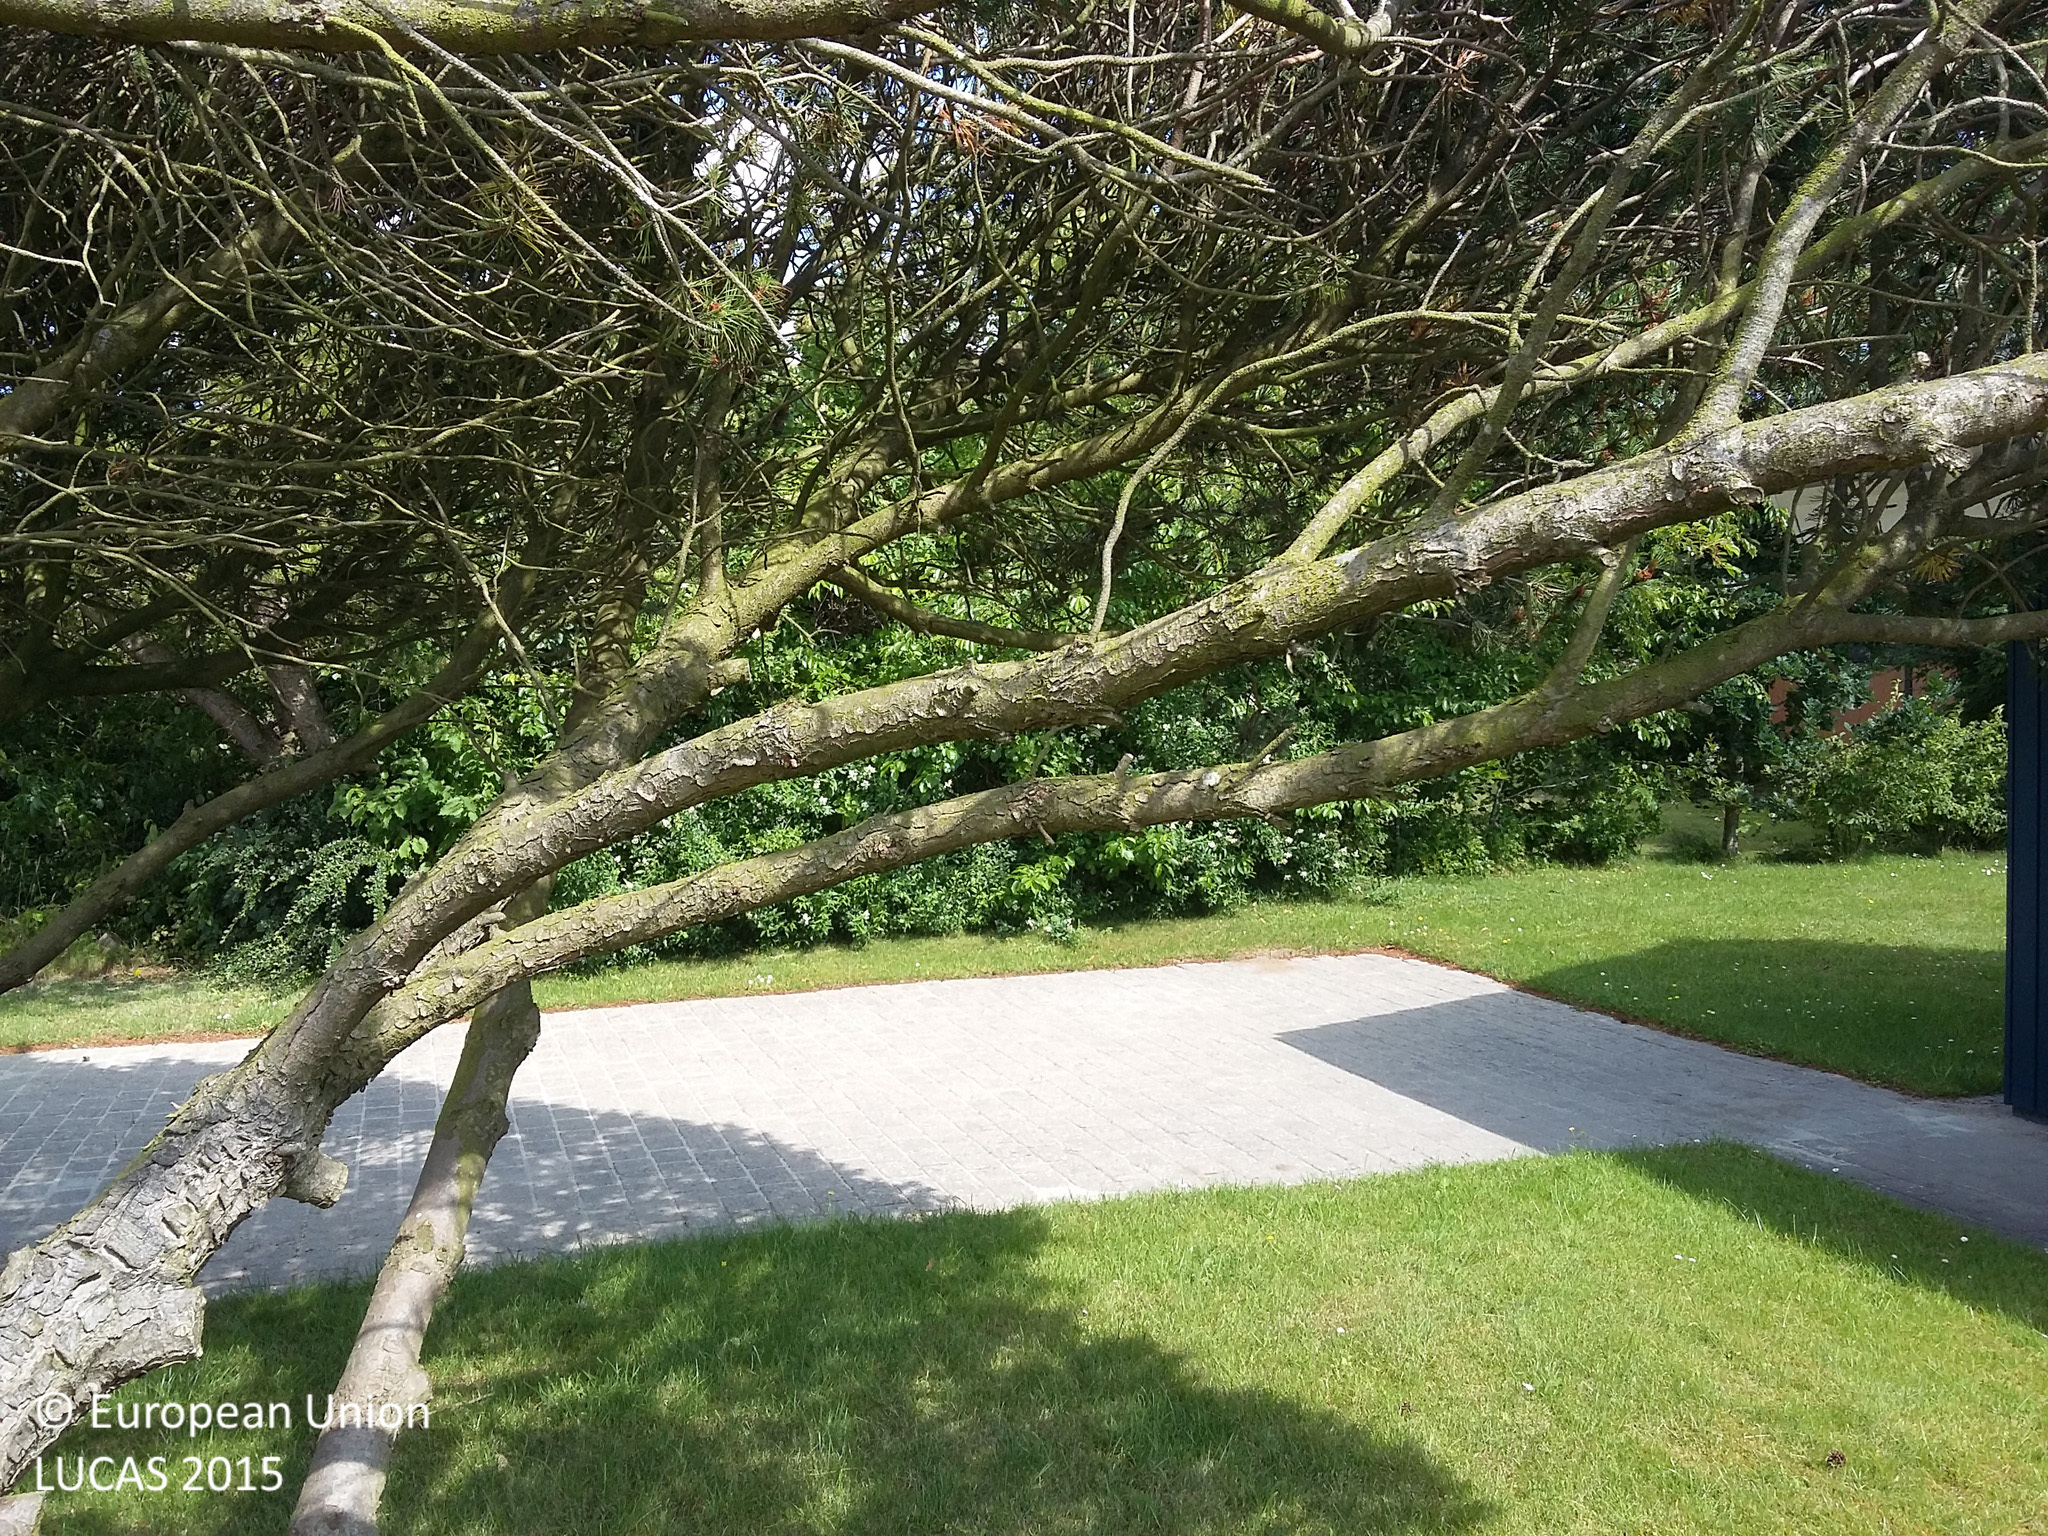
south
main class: Grassland
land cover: Grassland with sparse tree/shrub cover
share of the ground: > 75 %
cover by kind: herbaceous plants 95 %, coniferous forest trees 5 %
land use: Residential
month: July
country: DK
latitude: 55.6962
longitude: 11.2557
